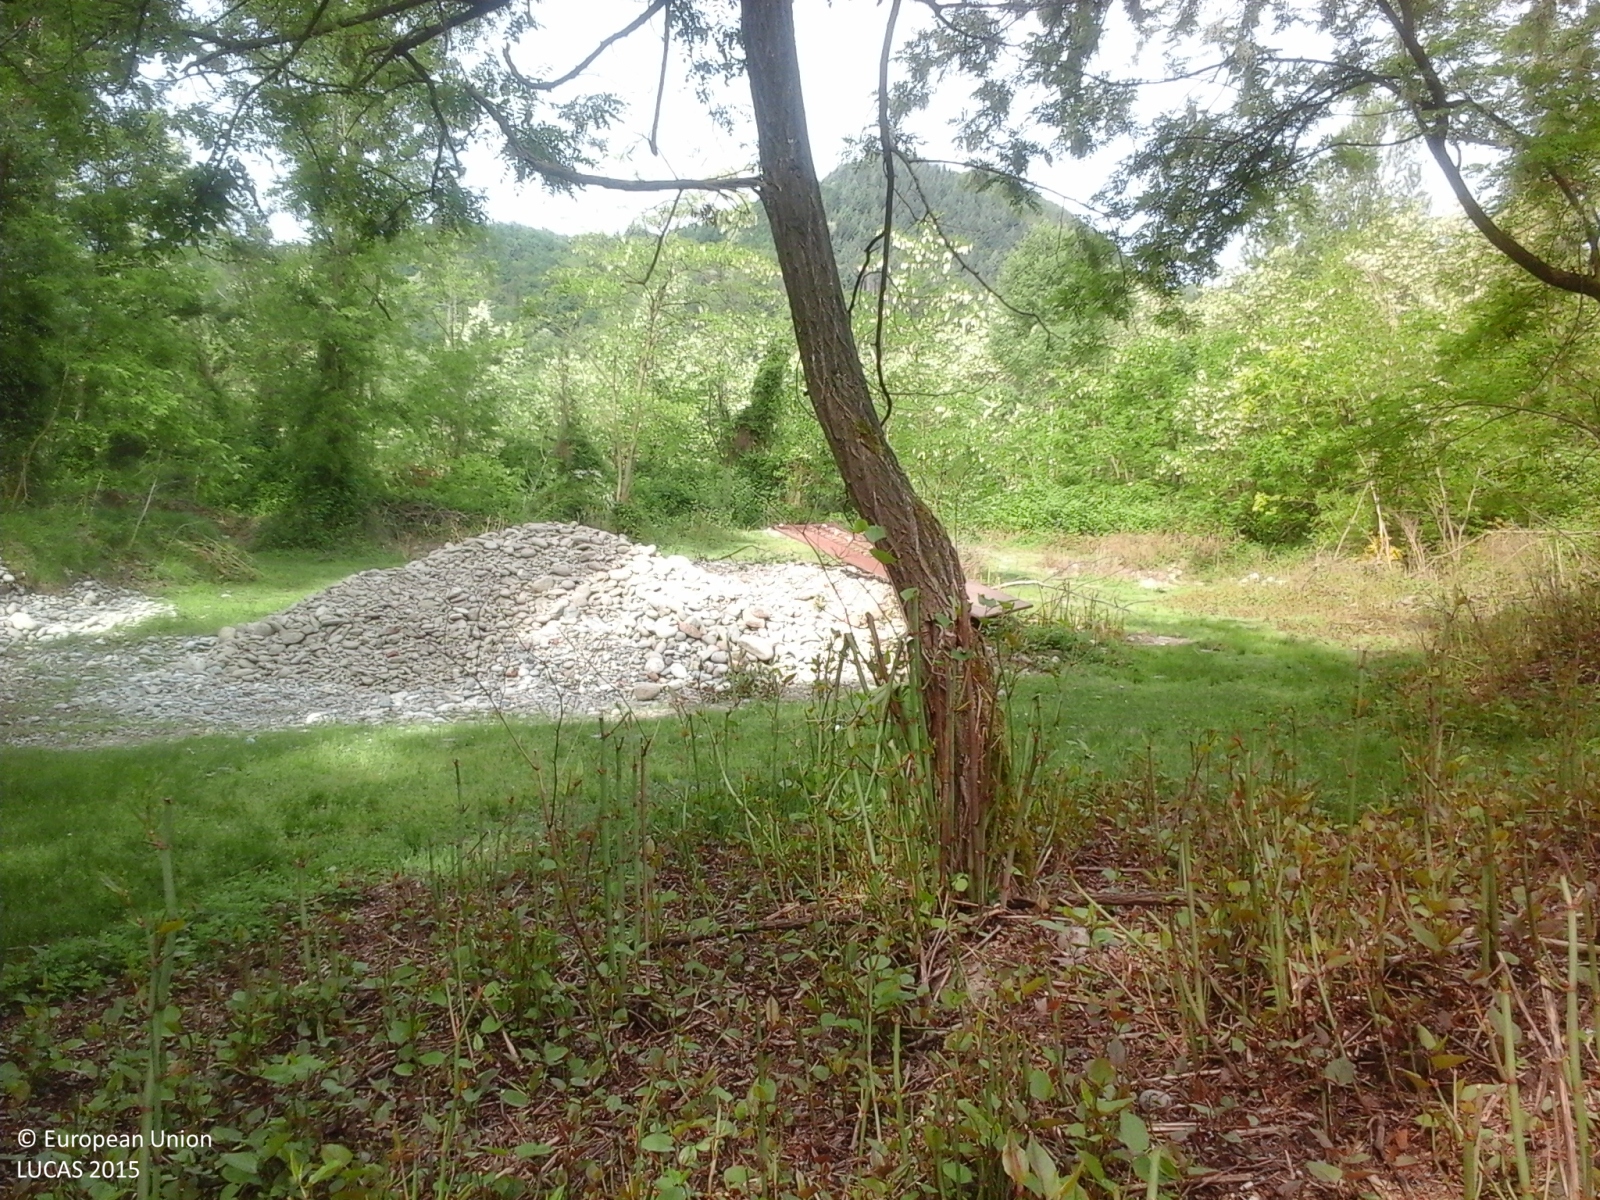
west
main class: Woodland
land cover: Broadleaved woodland
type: non-riverine alder, birch or aspen forest
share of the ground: > 75 %
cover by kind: broadleaved forest trees 100 %
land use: Forestry
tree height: < 5 m
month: May
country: IT
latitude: 45.7069
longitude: 8.2943
